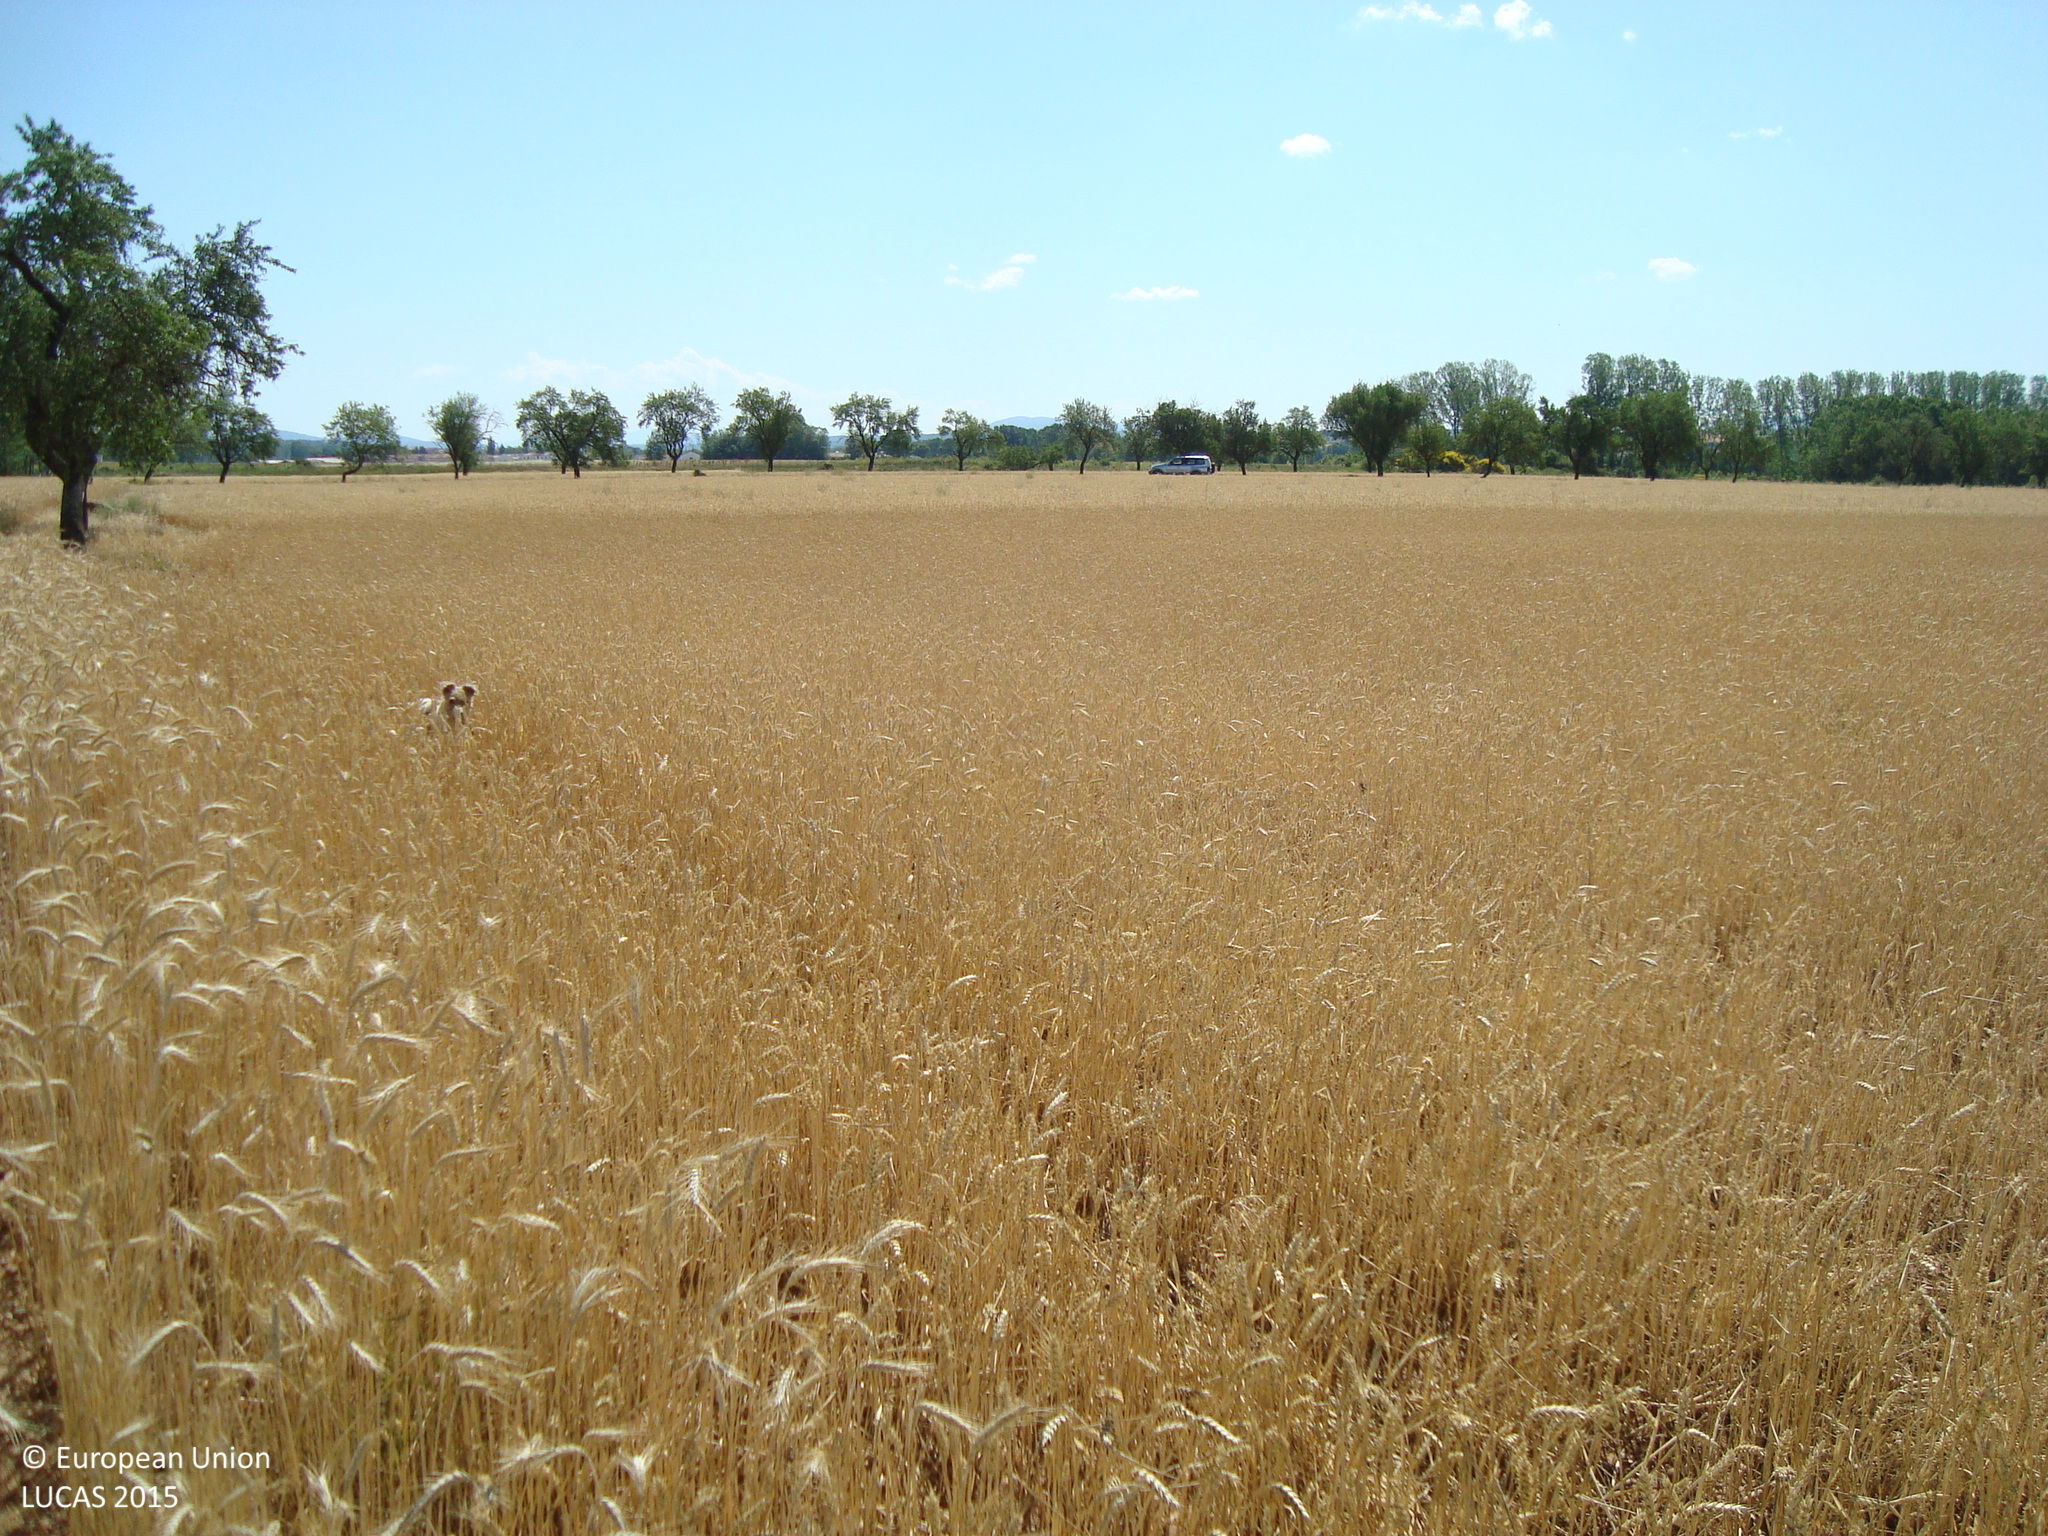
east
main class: Cropland
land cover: Barley
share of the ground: > 75 %
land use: Agriculture (excluding fallow land and kitchen gardens)
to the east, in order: Barley; Common wheat; Grassland without tree/shrub cover; Lines of trees; Grassland without tree/shrub cover; Other bare soil; Lines of trees; Common wheat; Grassland without tree/shrub cover
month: June
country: ES
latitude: 42.0300
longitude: -3.6936
